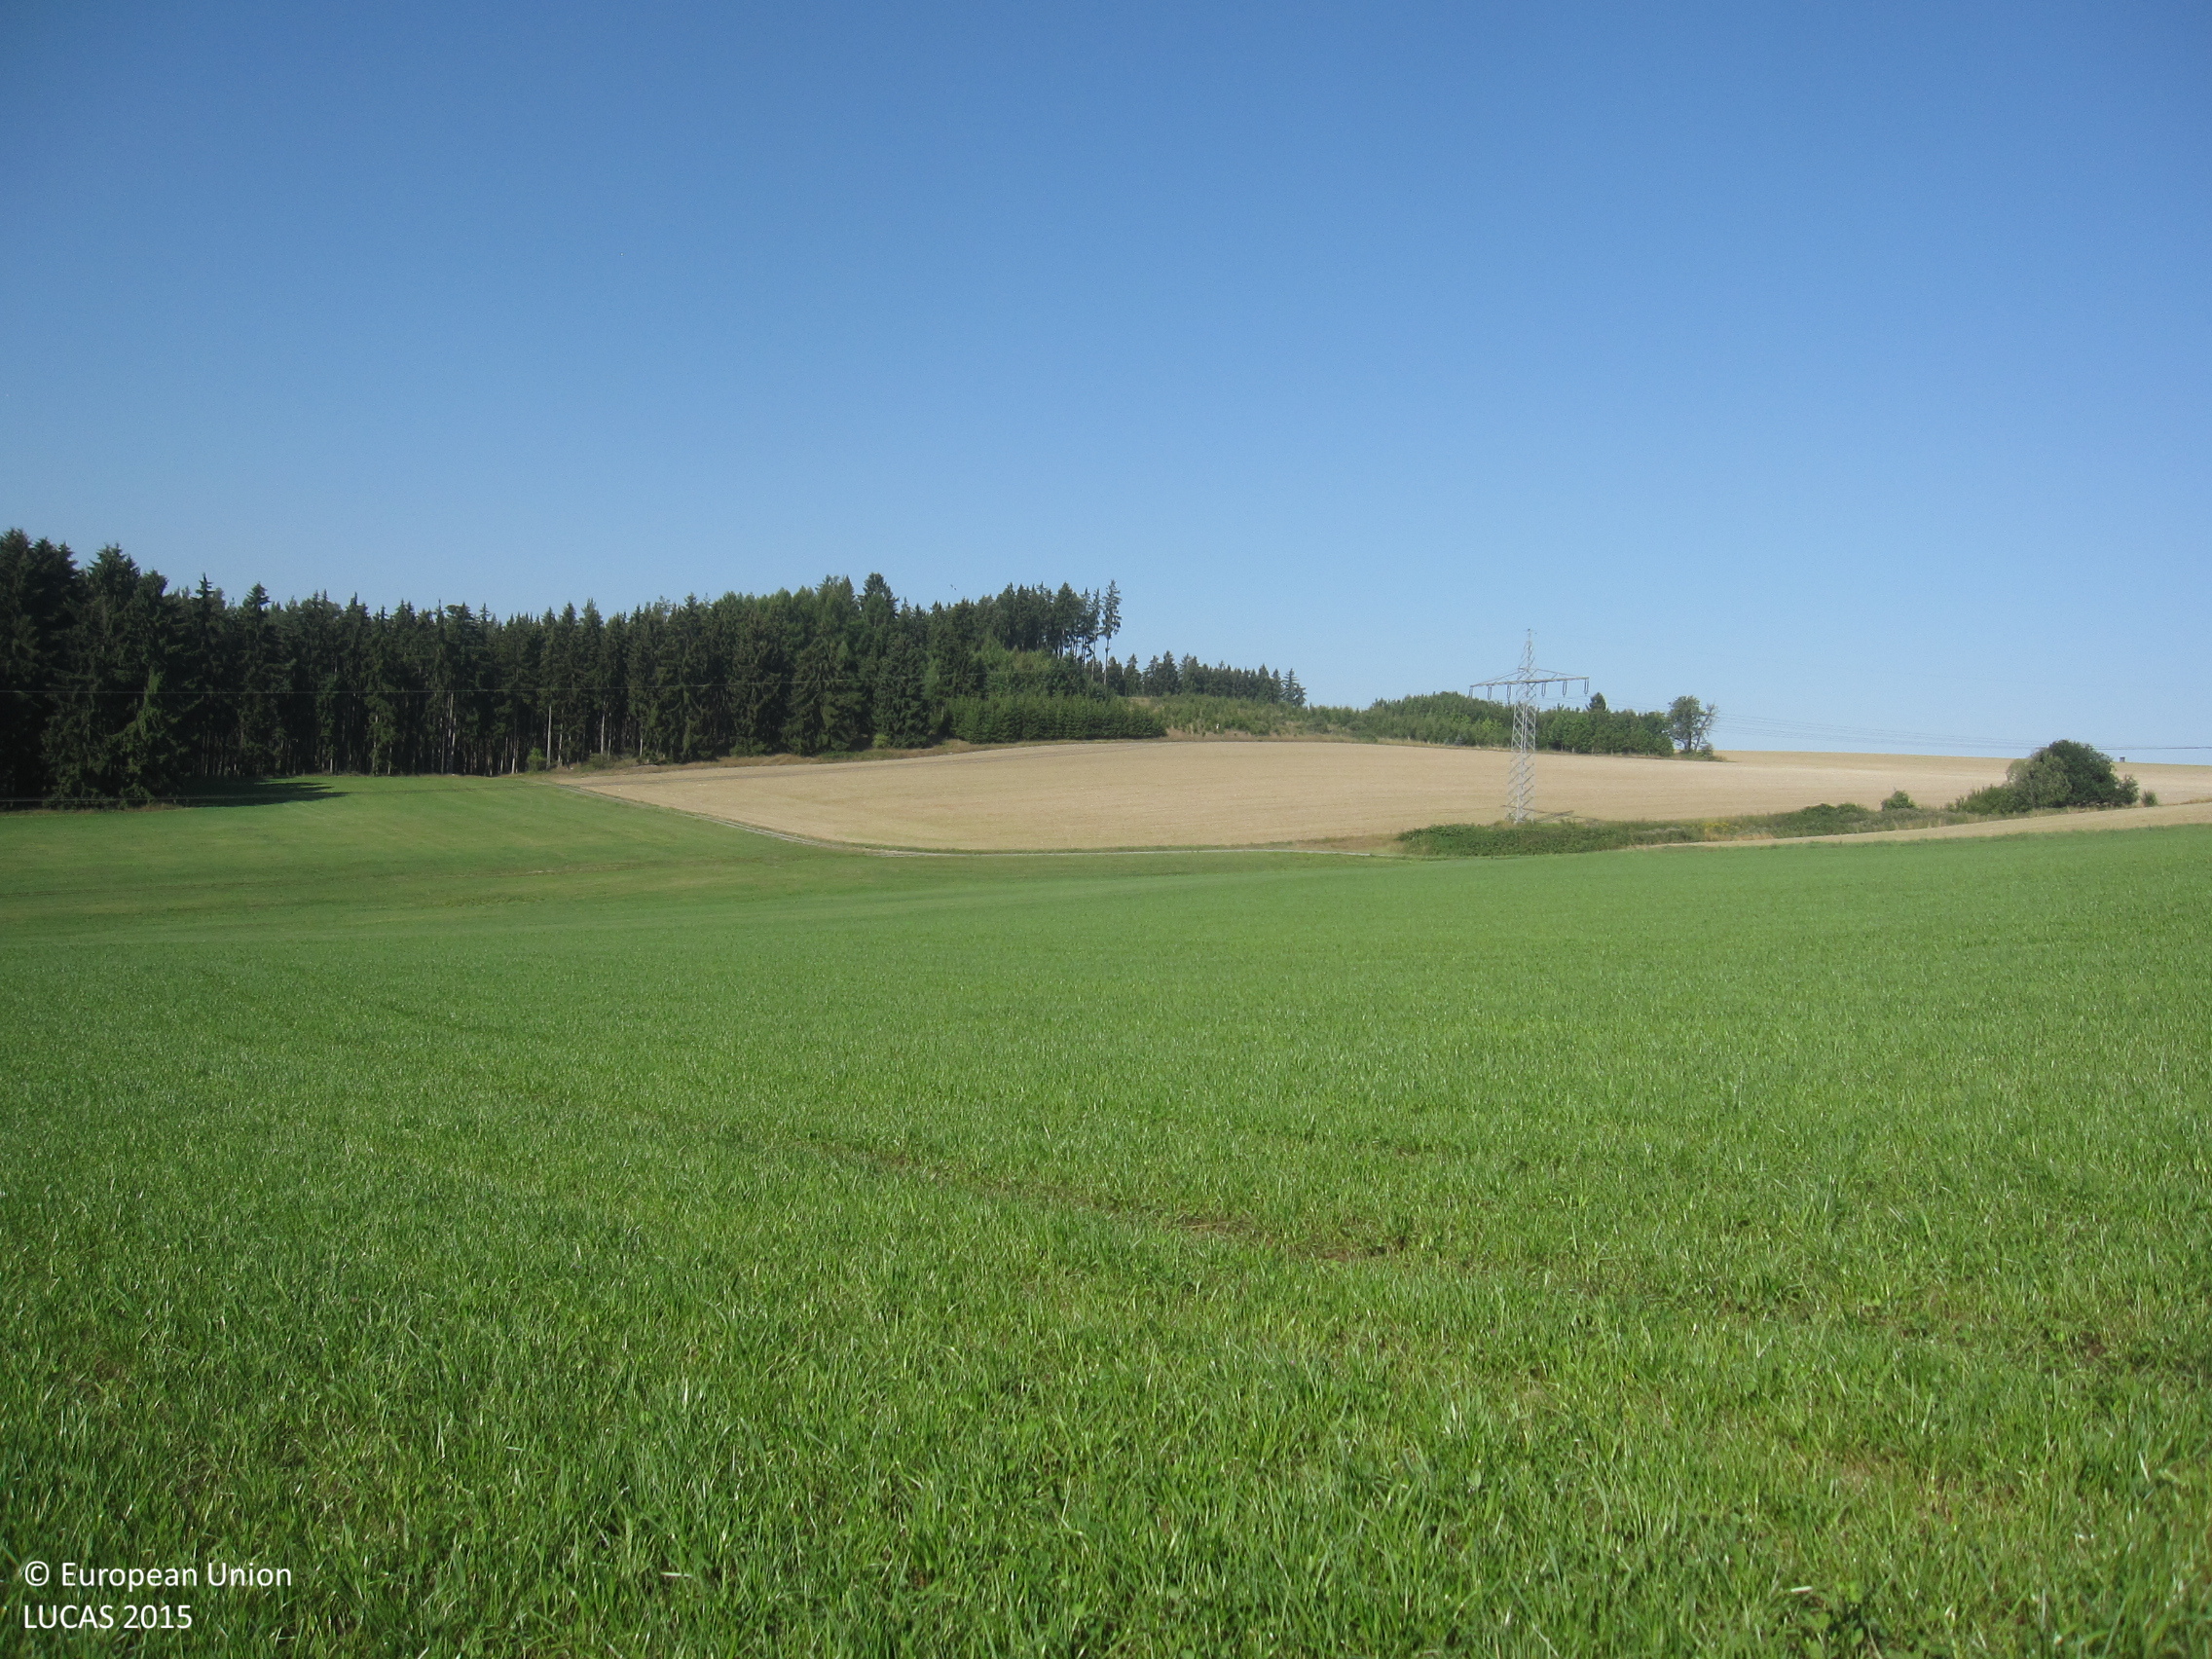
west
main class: Cropland
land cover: Temporary grasslands
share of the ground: > 75 %
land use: Agriculture (excluding fallow land and kitchen gardens)
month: August
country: DE
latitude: 50.5508
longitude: 11.5945
